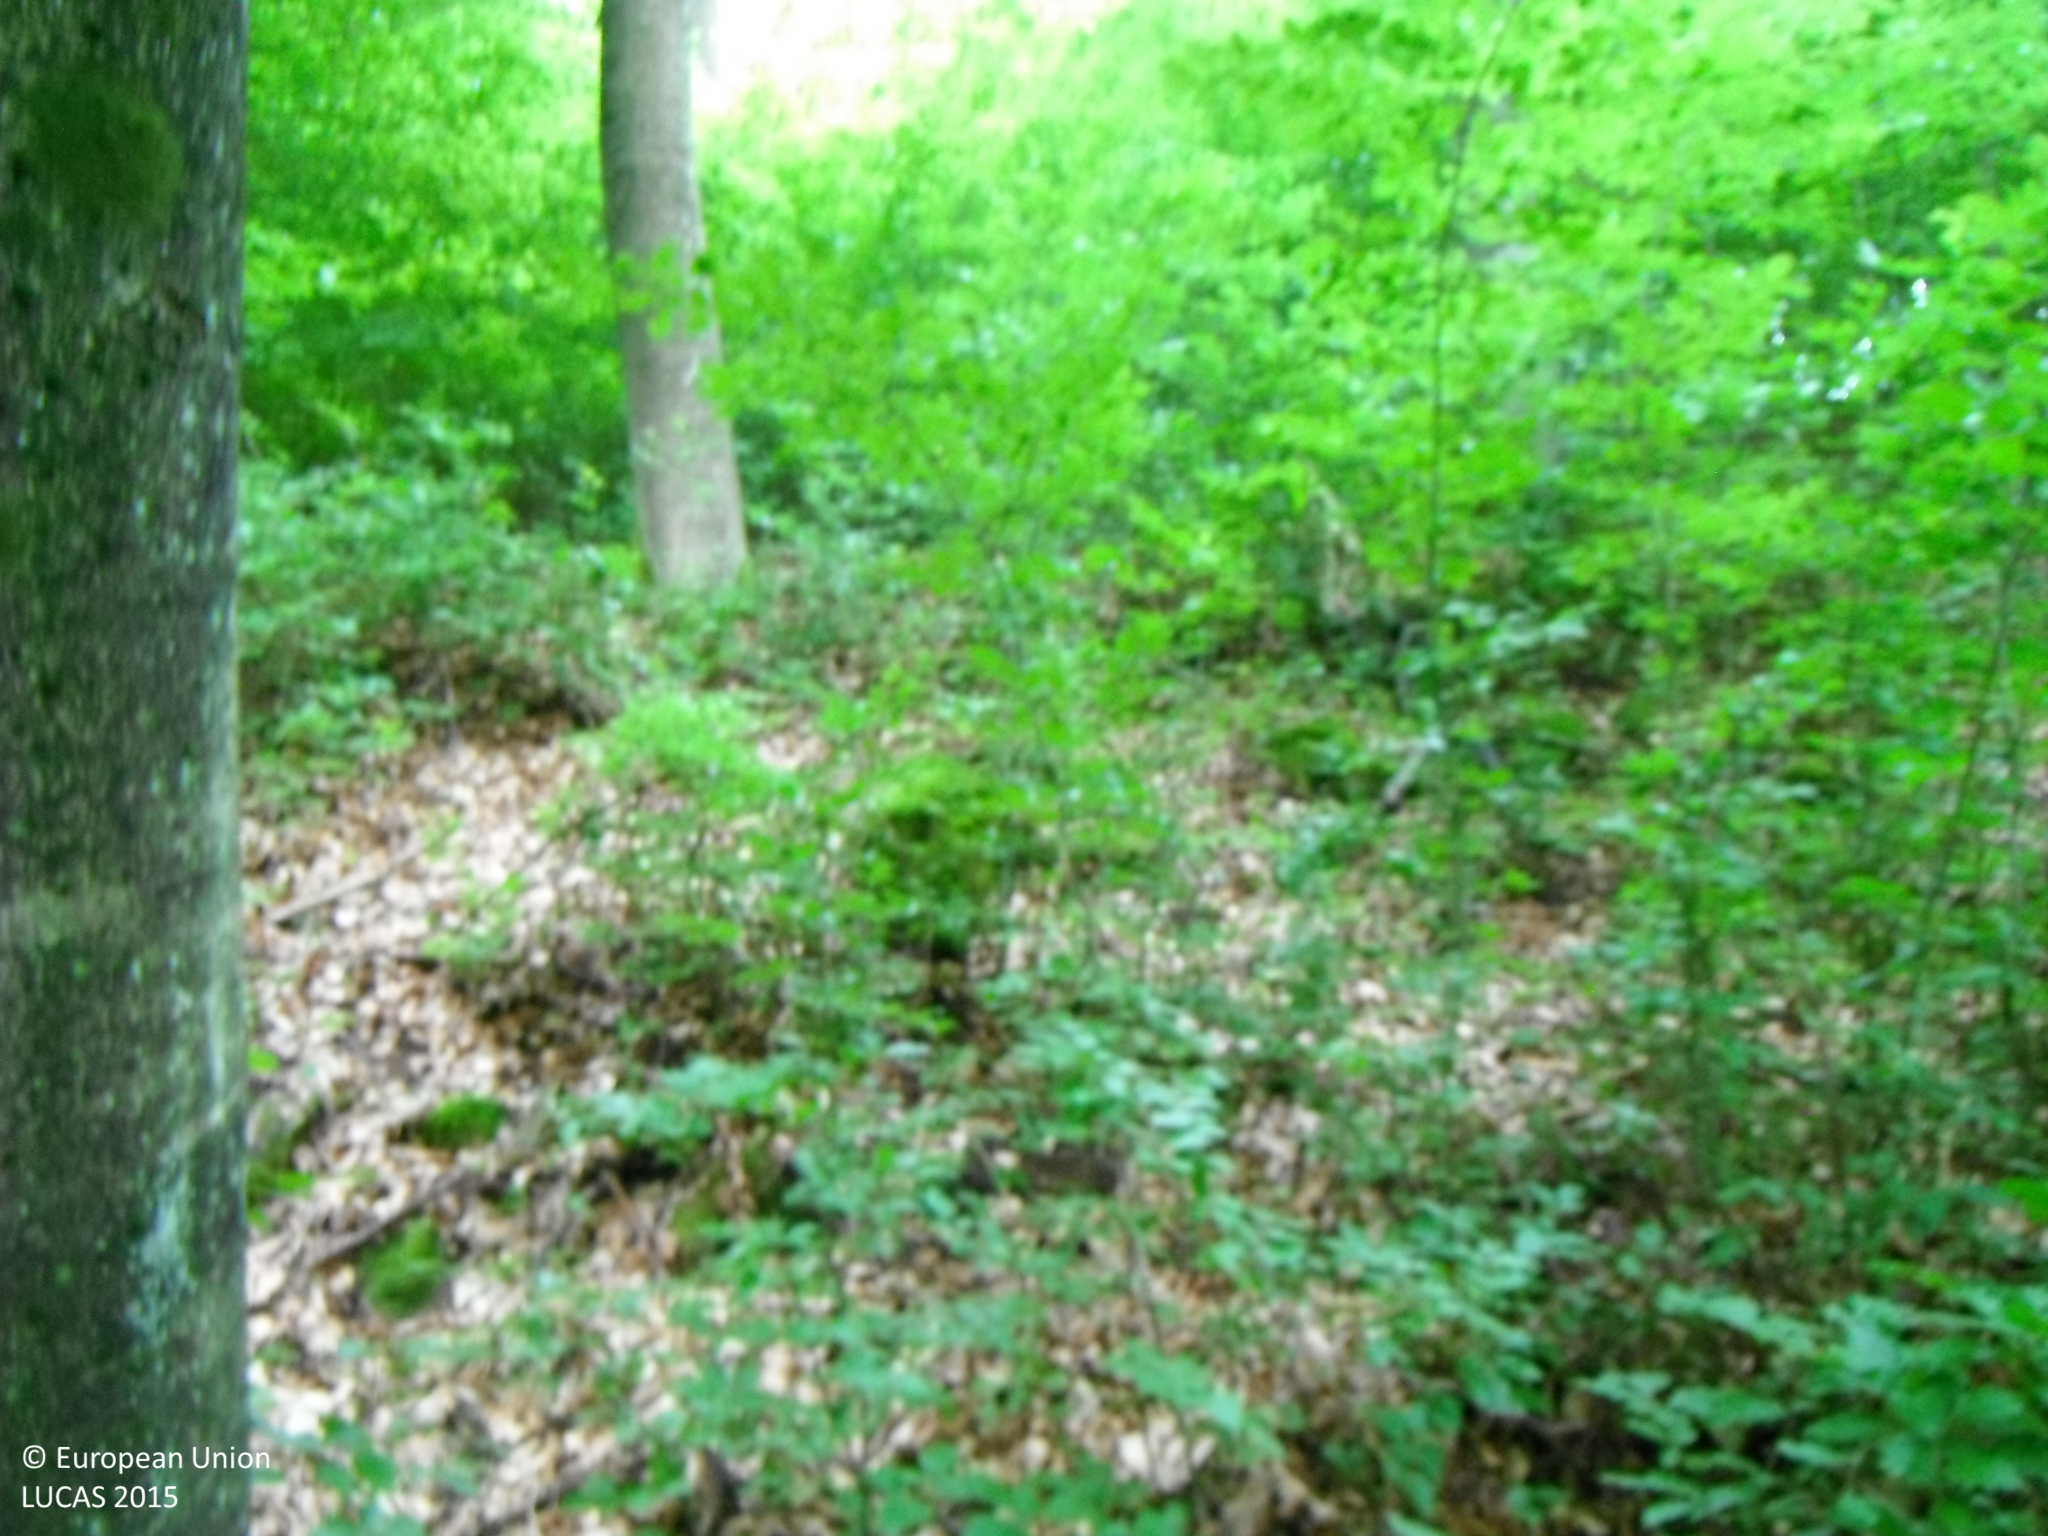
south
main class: Woodland
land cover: Broadleaved woodland
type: beech forest
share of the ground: > 75 %
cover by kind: broadleaved forest trees 100 %
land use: Forestry
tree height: > 5 m
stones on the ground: 25 - 50 %
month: June
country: SK
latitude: 48.5056
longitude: 20.0598
